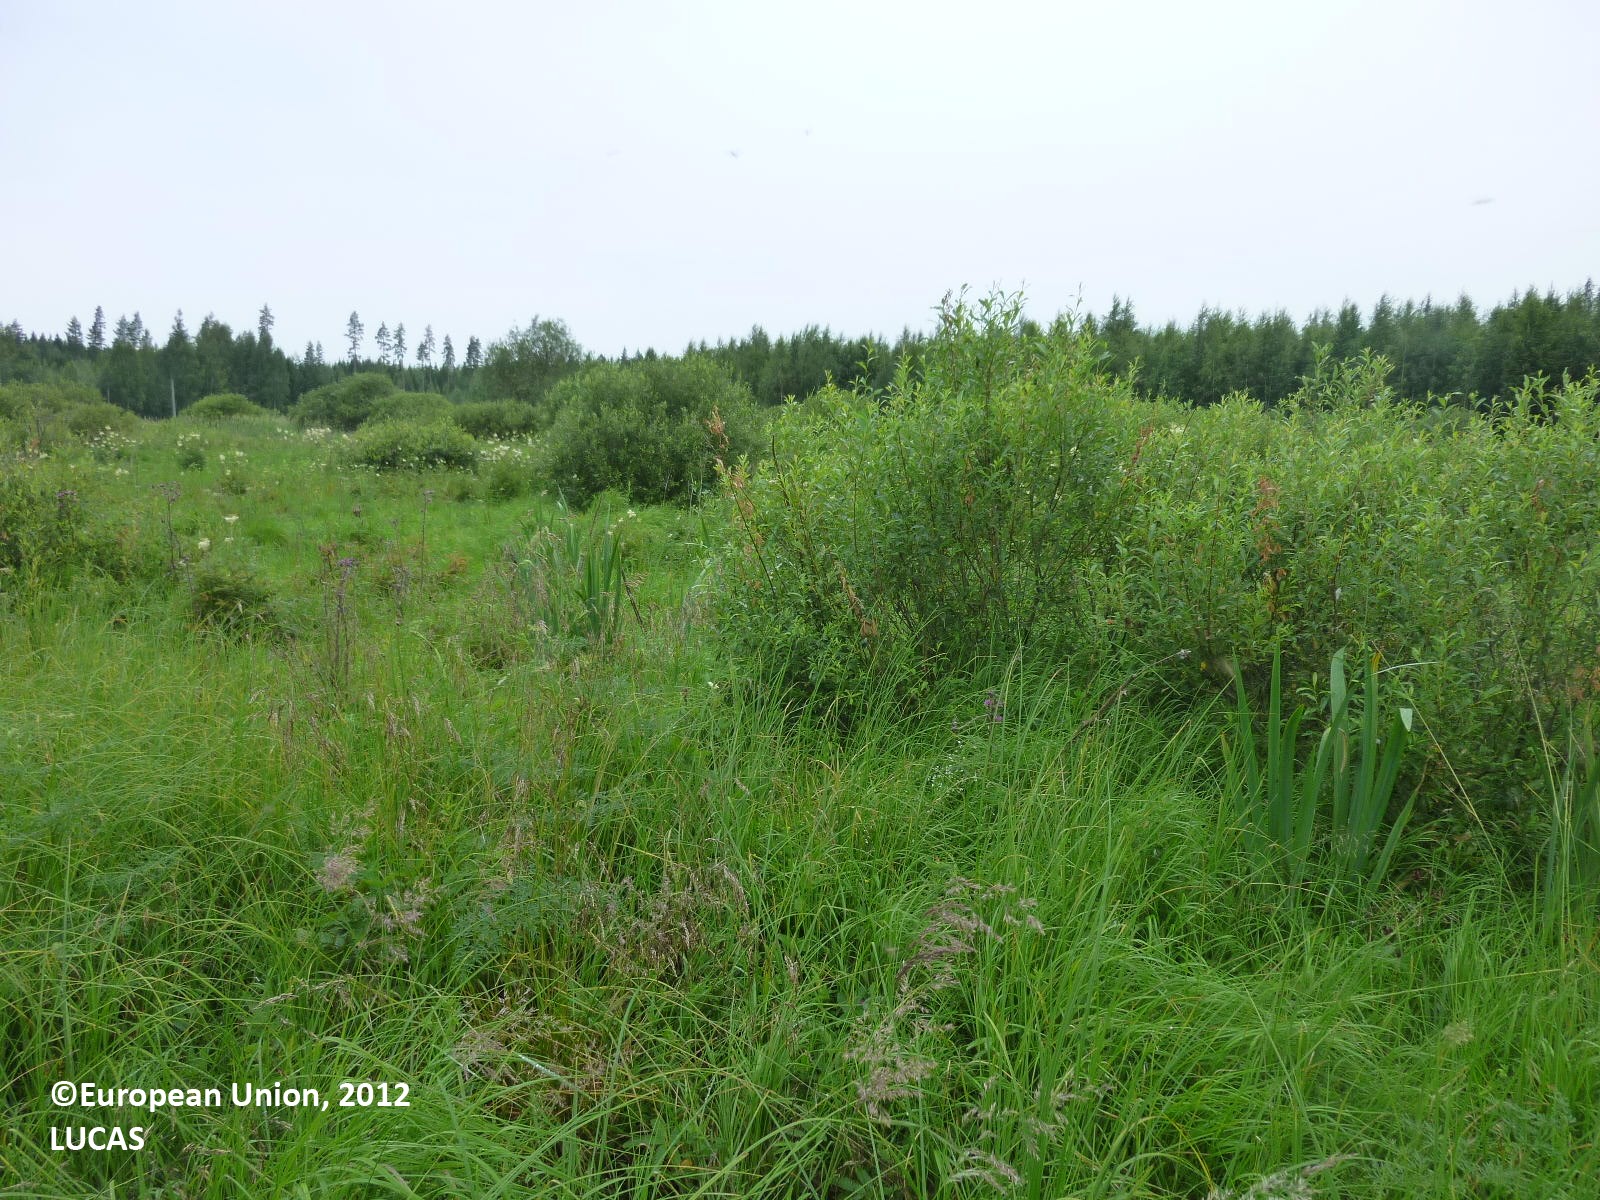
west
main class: Grassland
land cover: Grassland with sparse tree/shrub cover
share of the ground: > 75 %
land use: Fallow land
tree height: > 5 m
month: July
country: FI
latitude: 61.4210
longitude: 22.1839
